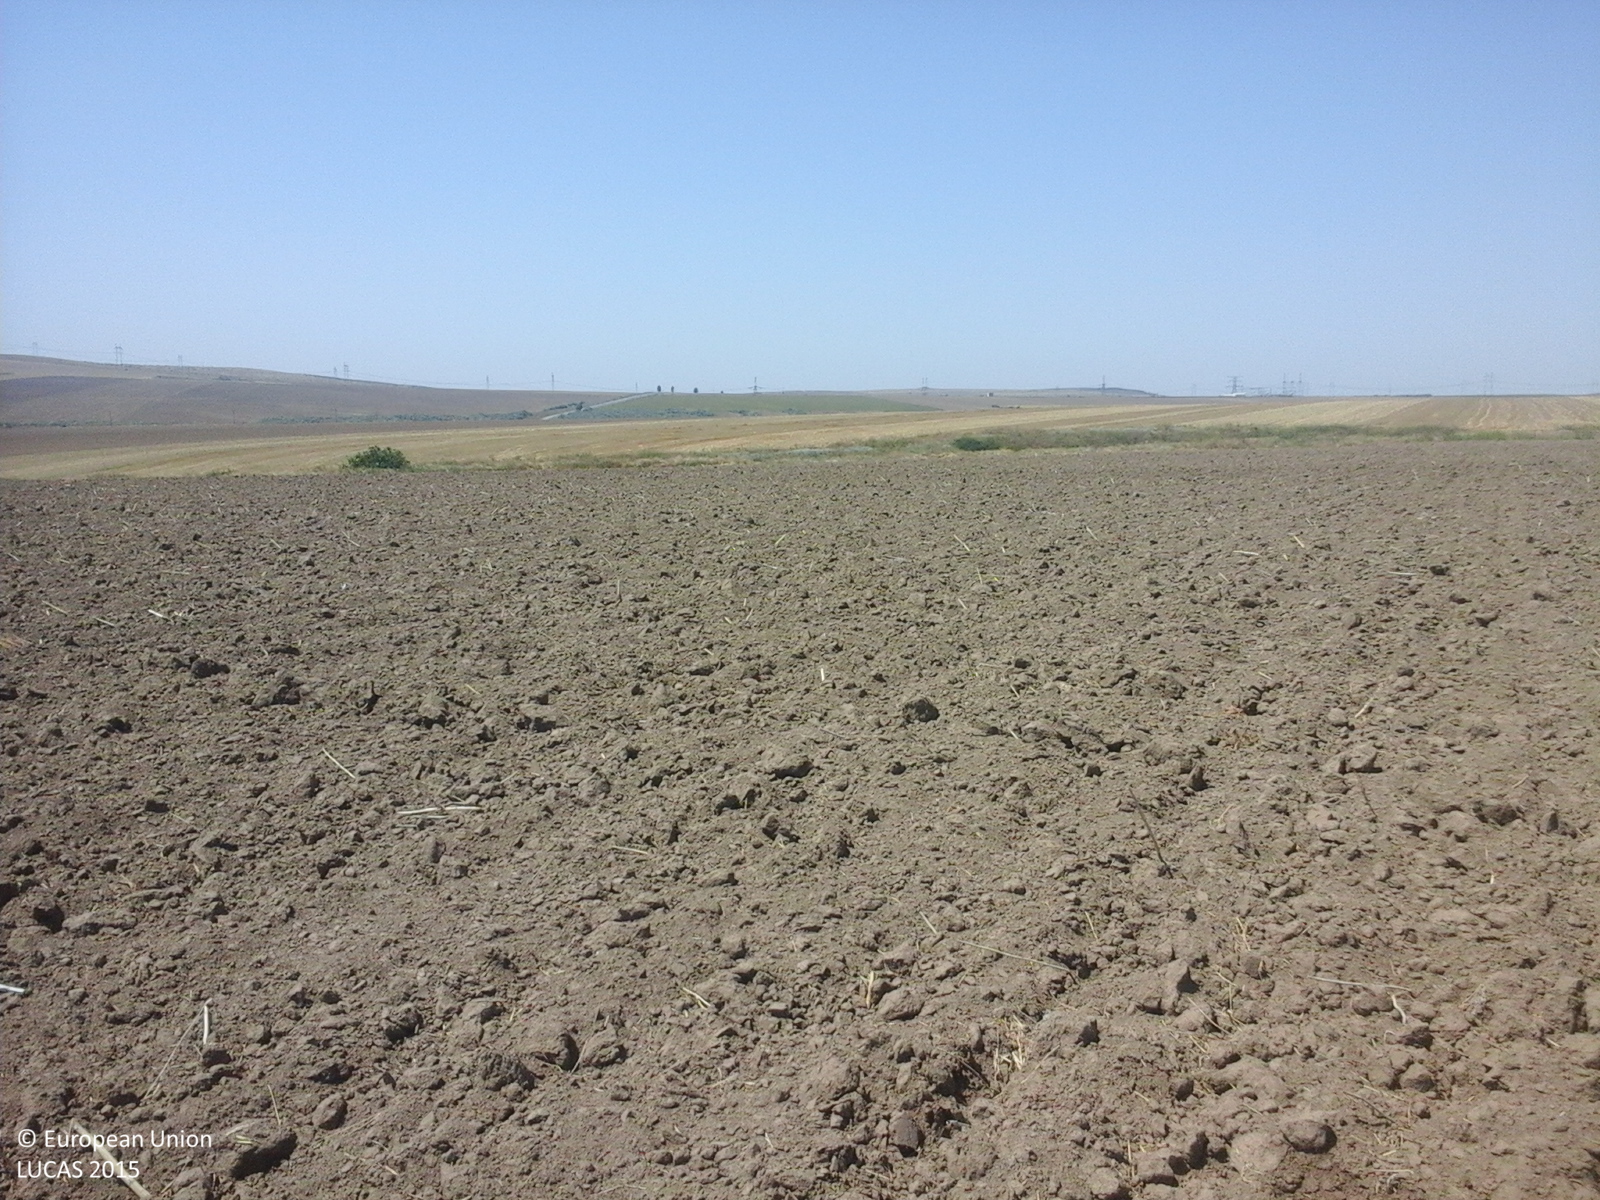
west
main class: Cropland
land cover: Rape and turnip rape
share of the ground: < 10 %
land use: Agriculture (excluding fallow land and kitchen gardens)
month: August
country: RO
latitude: 44.5462
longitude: 28.2278
